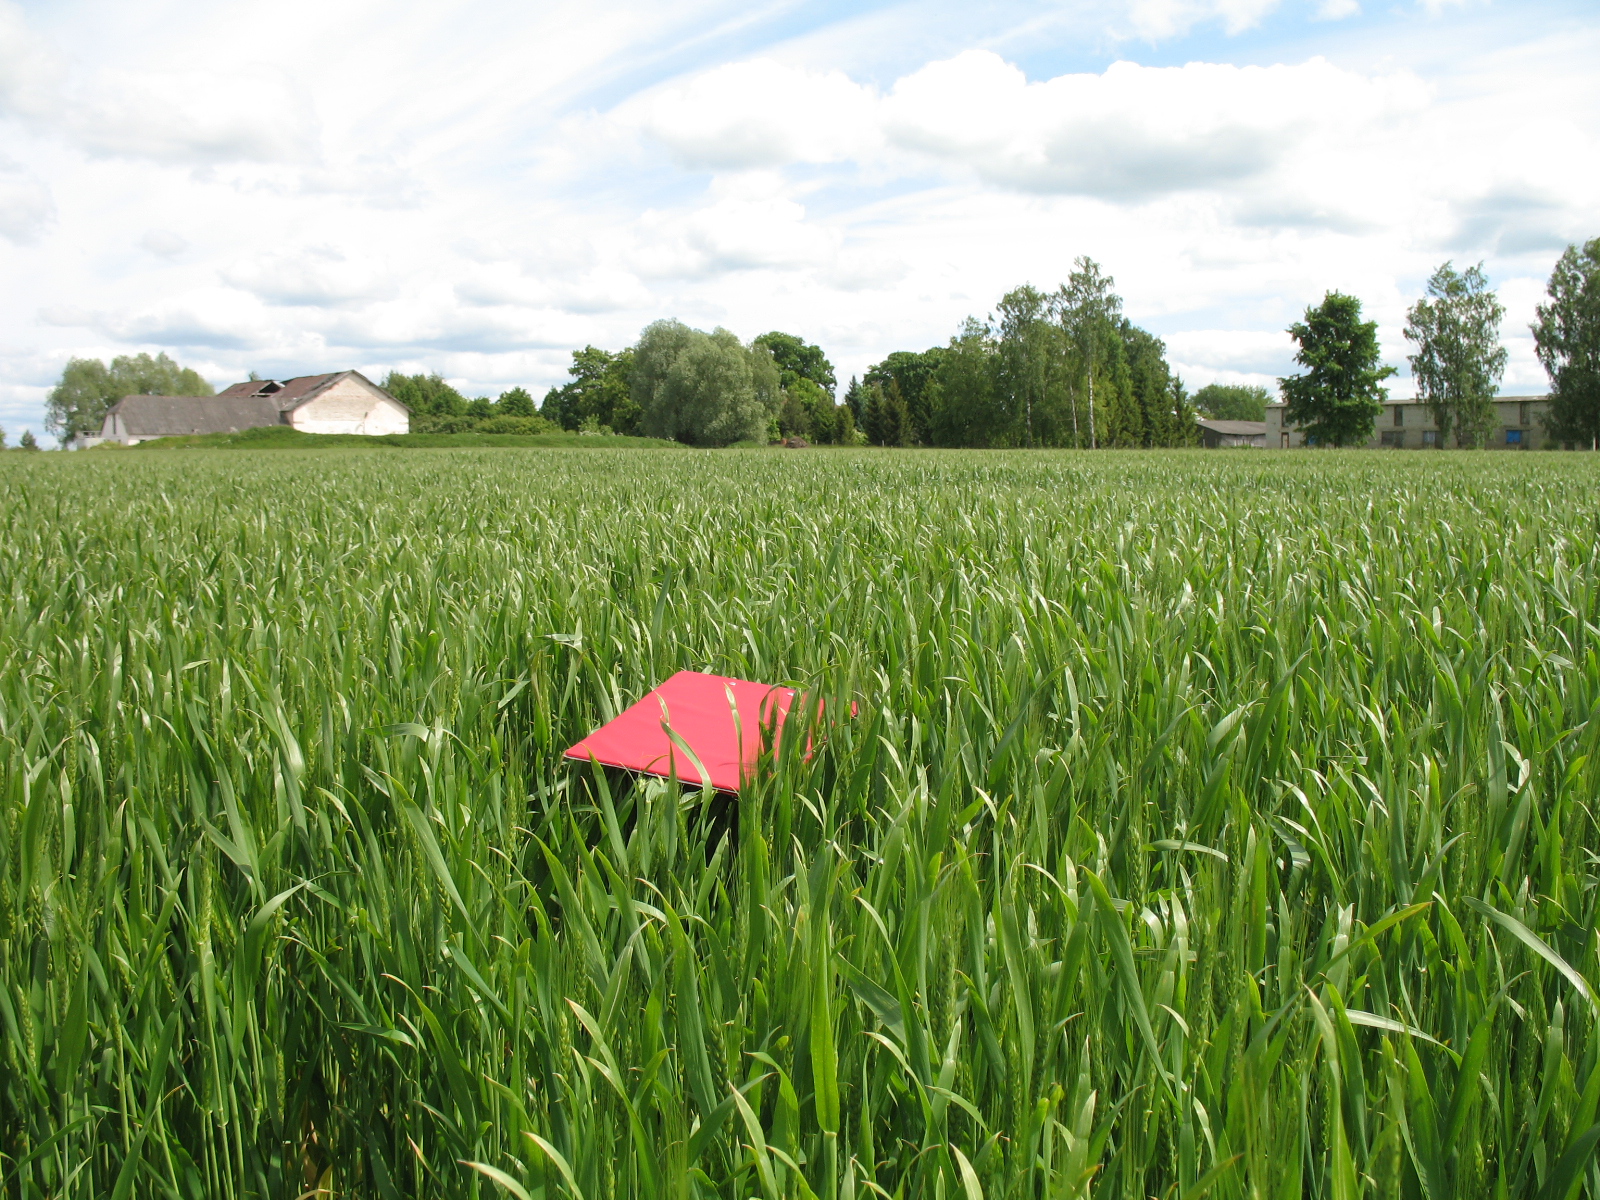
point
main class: Cropland
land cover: Barley
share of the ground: > 75 %
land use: Agriculture (excluding fallow land and kitchen gardens)
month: June
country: LV
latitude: 56.6076
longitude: 23.4489
